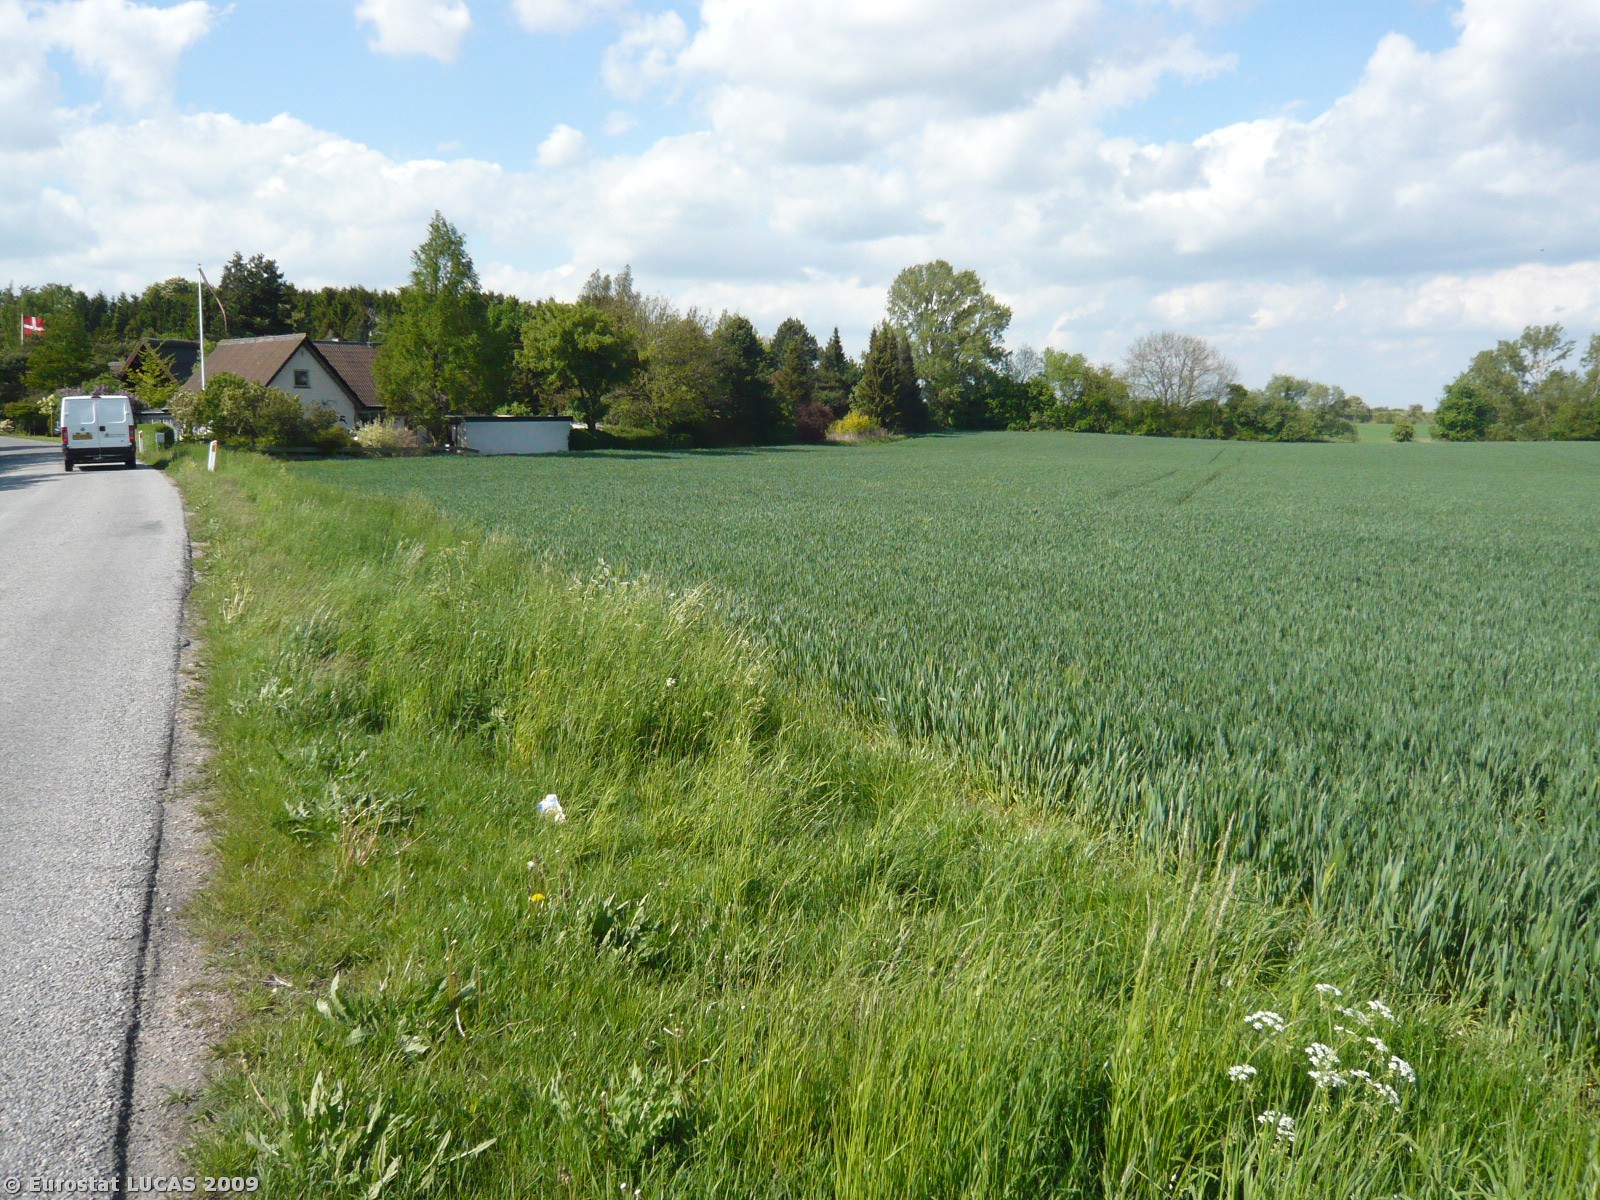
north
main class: Cropland
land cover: Common wheat
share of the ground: > 75 %
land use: Agriculture (excluding fallow land and kitchen gardens)
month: May
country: DK
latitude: 55.4143
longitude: 12.1624
